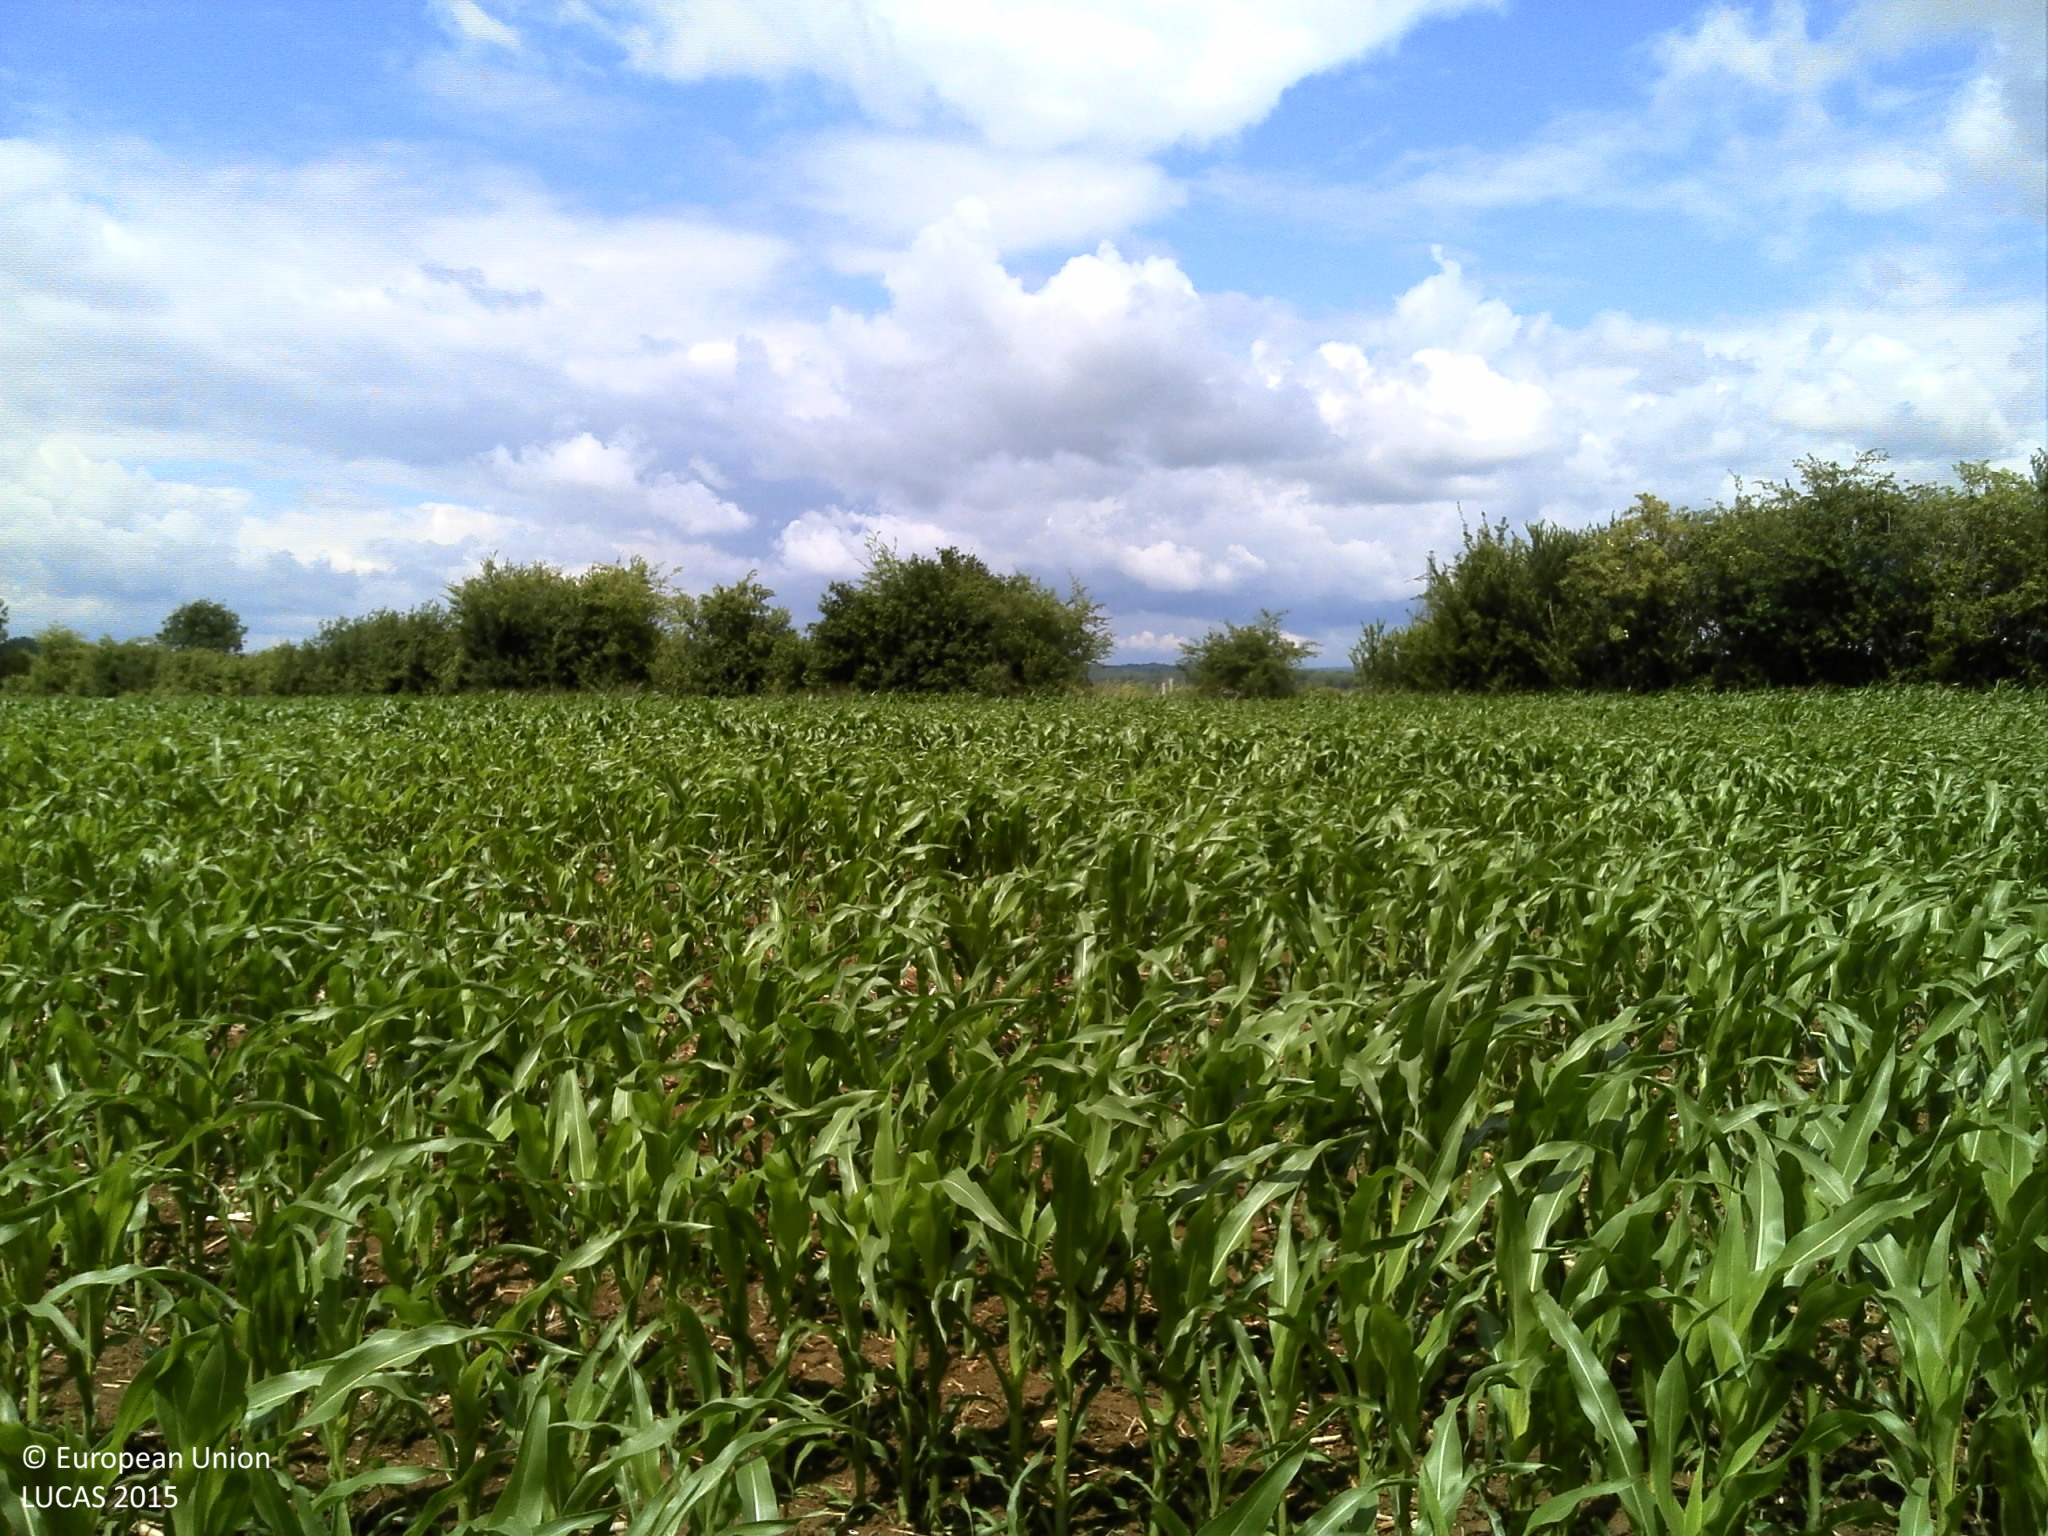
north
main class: Cropland
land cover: Maize
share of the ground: 50 - 75 %
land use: Agriculture (excluding fallow land and kitchen gardens)
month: June
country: FR
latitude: 49.6600
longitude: 4.9964
